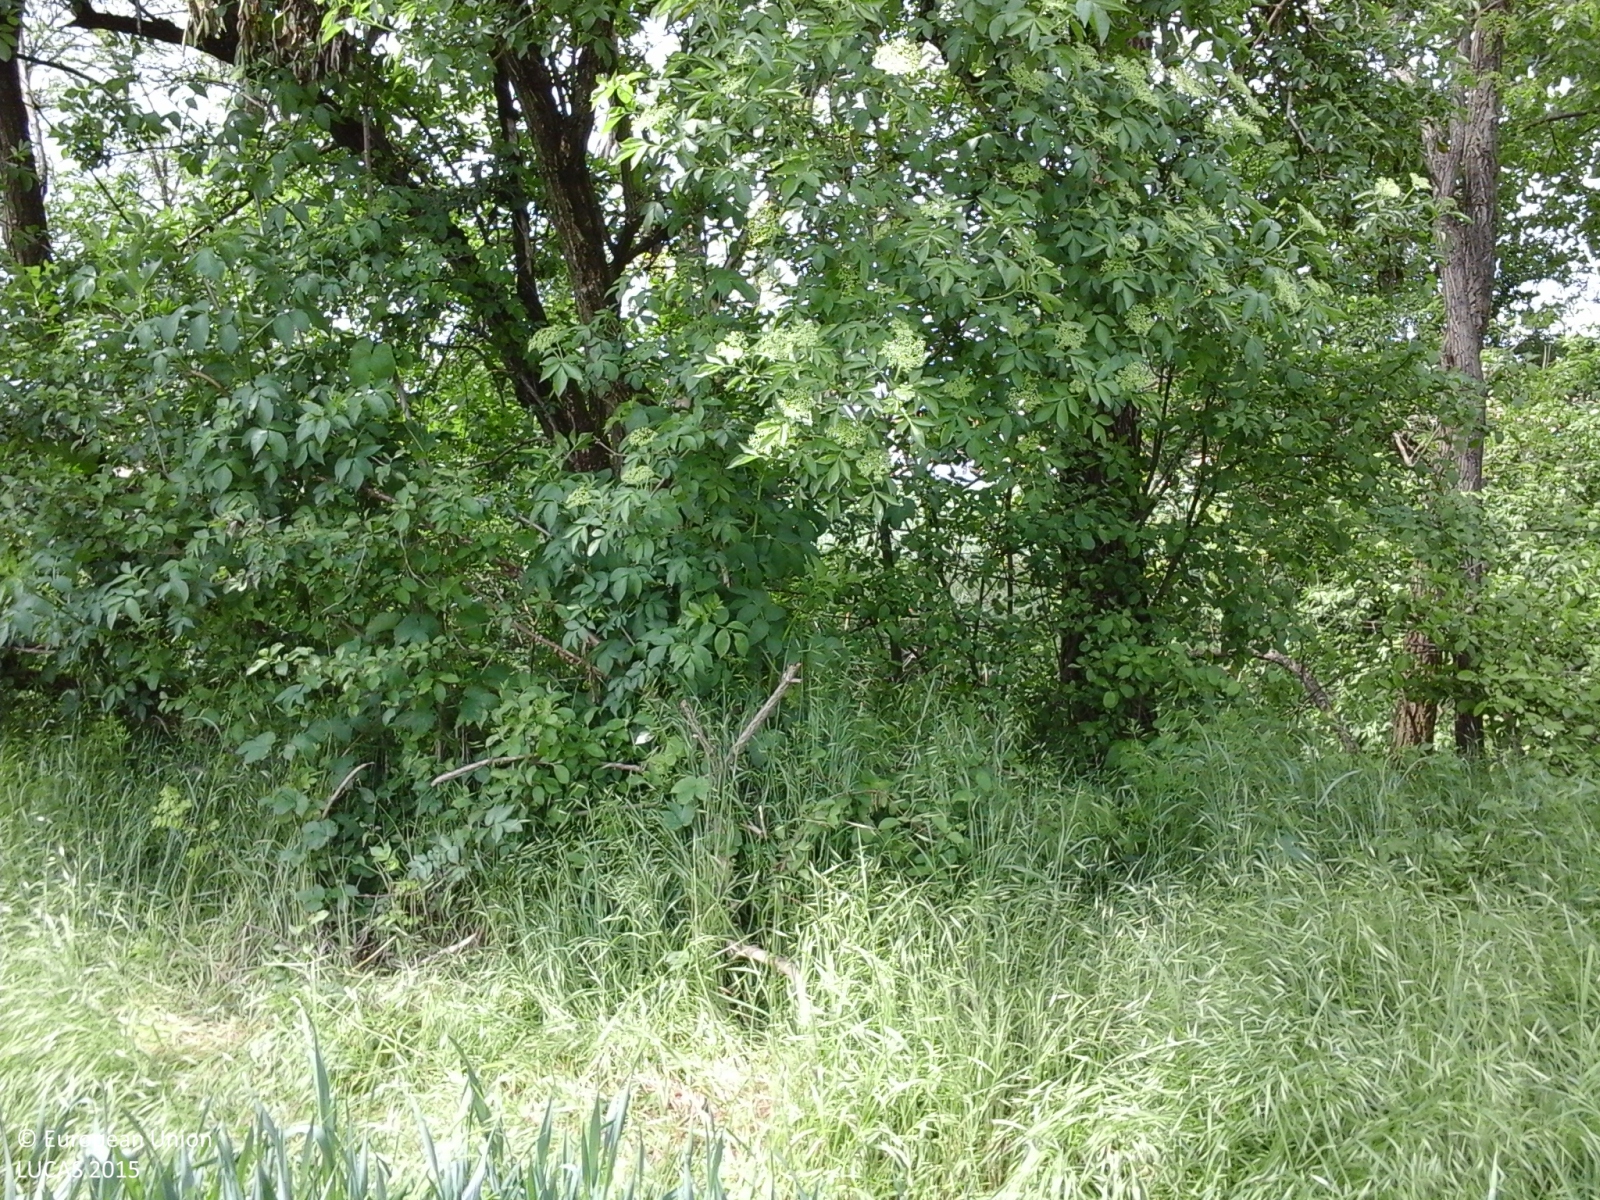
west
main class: Cropland
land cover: Common wheat
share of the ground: > 75 %
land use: Agriculture (excluding fallow land and kitchen gardens)
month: April
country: IT
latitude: 45.0528
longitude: 9.5564
